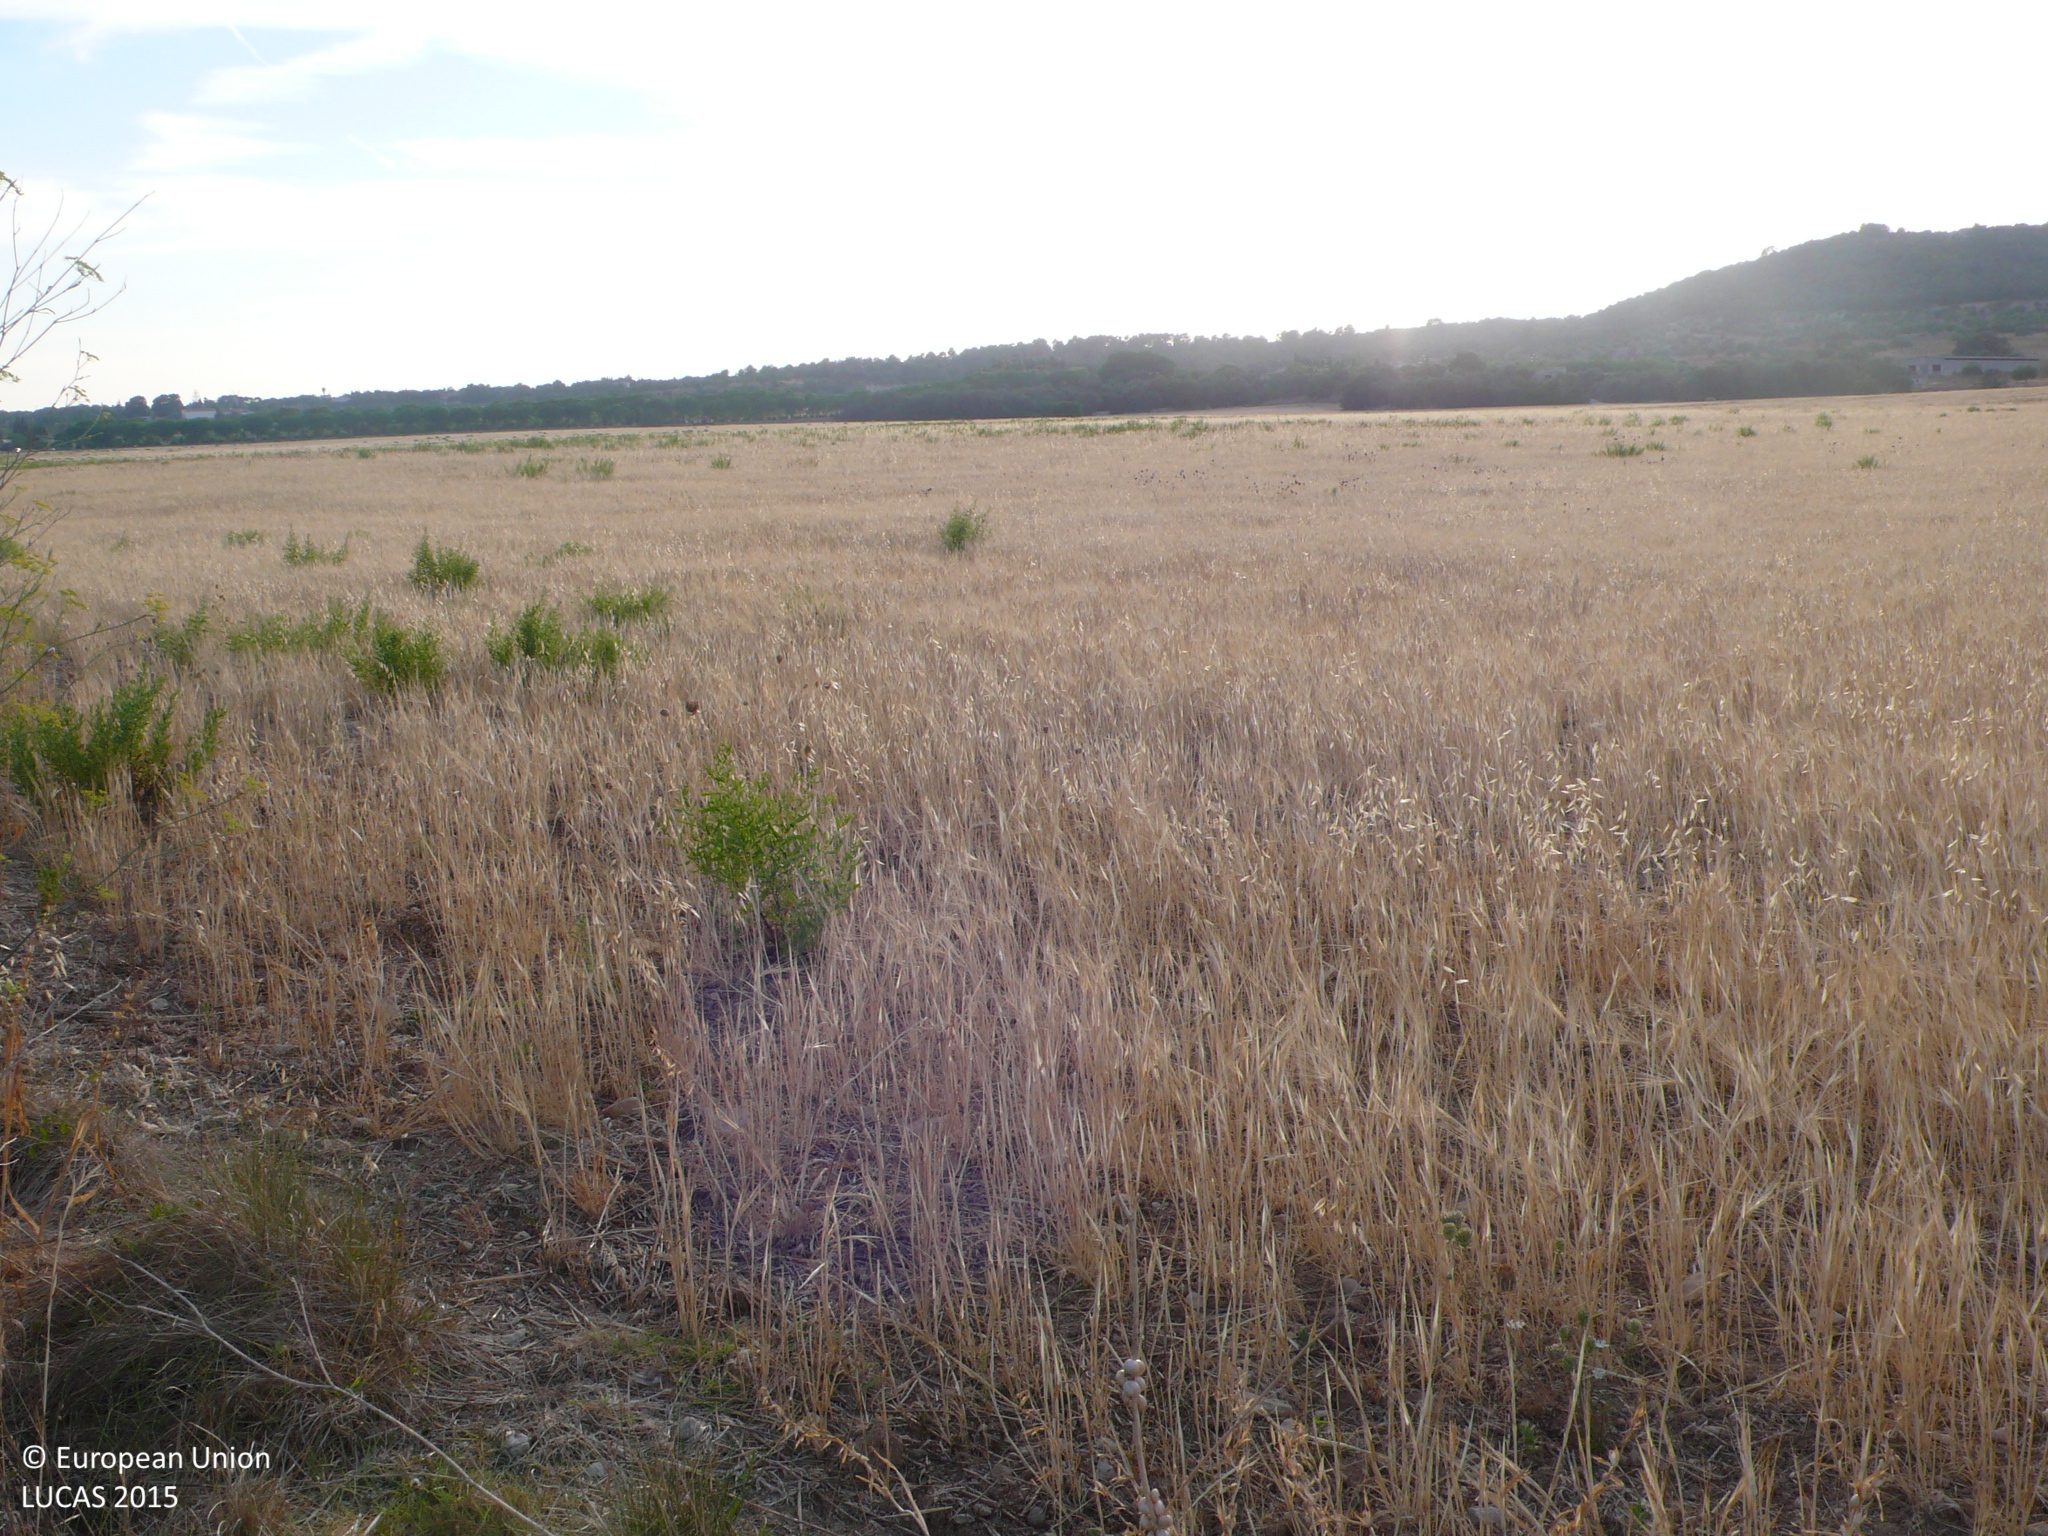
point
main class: Cropland
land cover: Mixed cereals for fodder
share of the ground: > 75 %
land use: Agriculture (excluding fallow land and kitchen gardens)
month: July
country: ES
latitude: 39.5637
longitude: 3.2673
